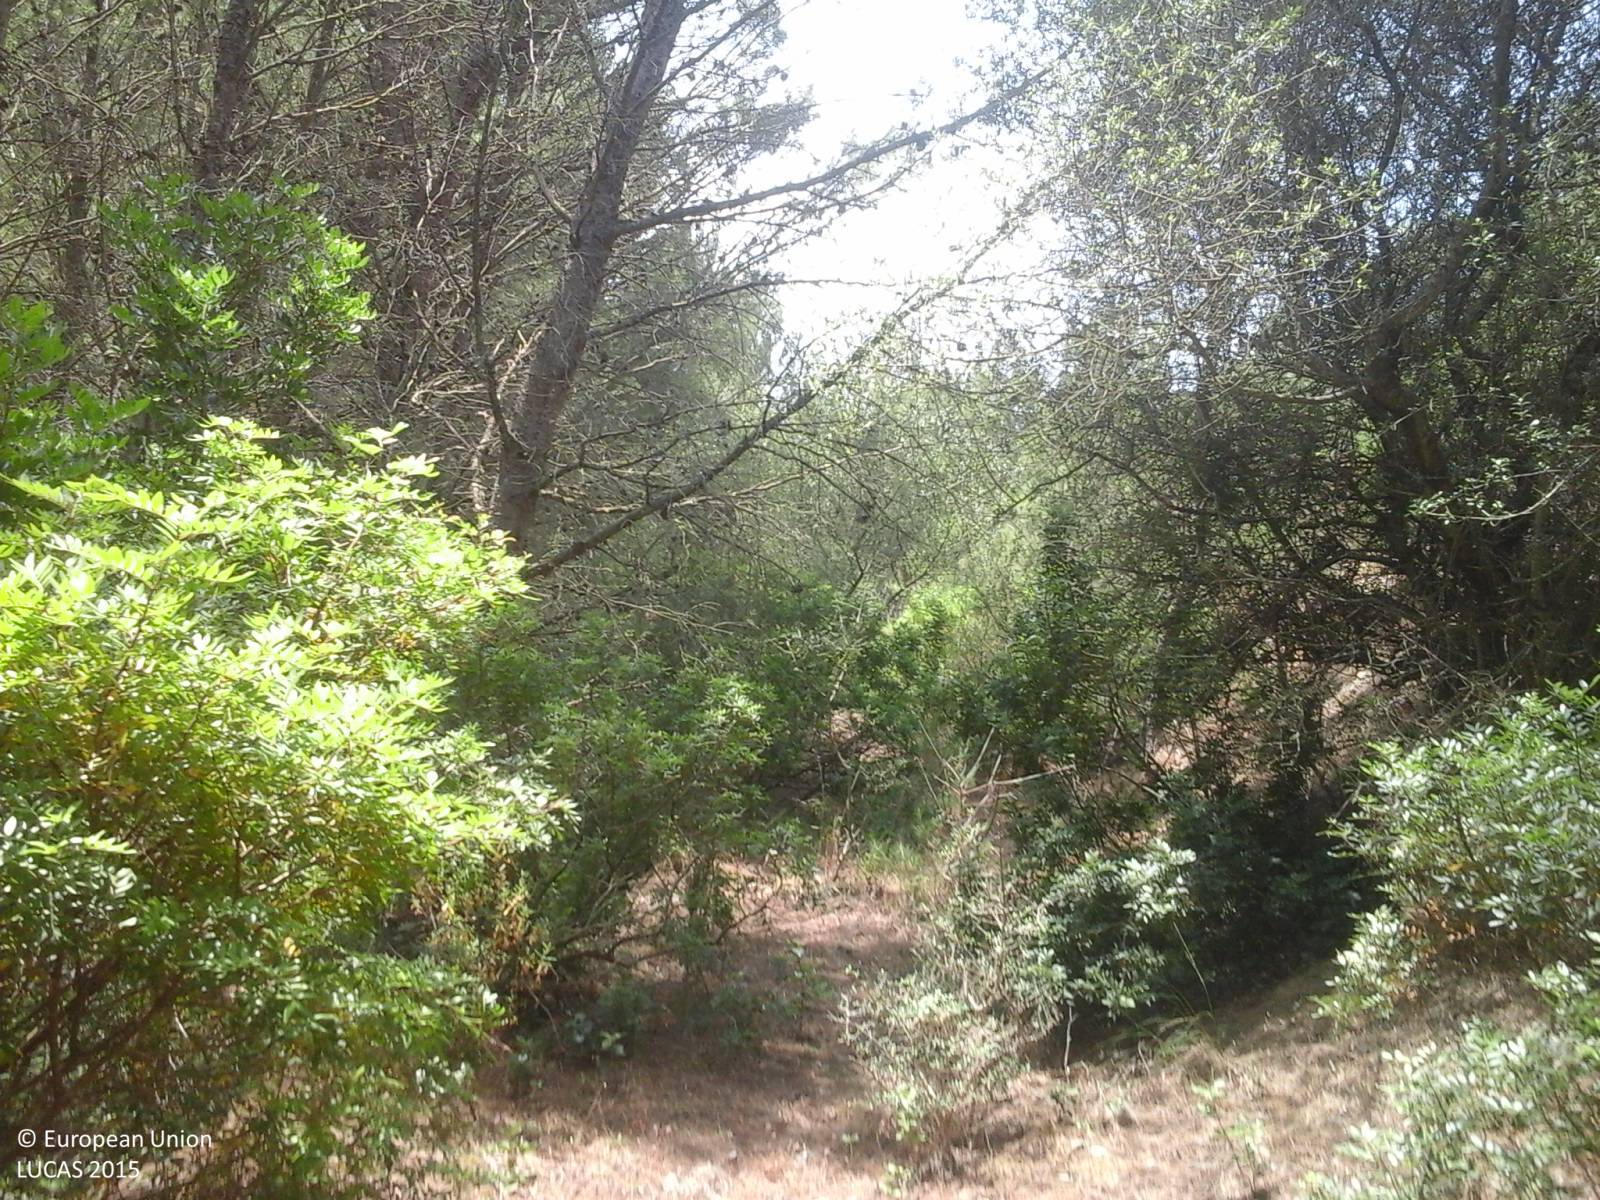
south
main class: Woodland
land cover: Other coniferous woodland
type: coniferous forest of the mediterranean region
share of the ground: > 75 %
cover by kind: coniferous forest trees 60 %, shrubs 25 %, herbaceous plants 10 %, broadleaved forest trees 5 %
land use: Semi-natural and natural areas not in use
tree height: > 5 m
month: July
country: IT
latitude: 39.2594
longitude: 8.4911
